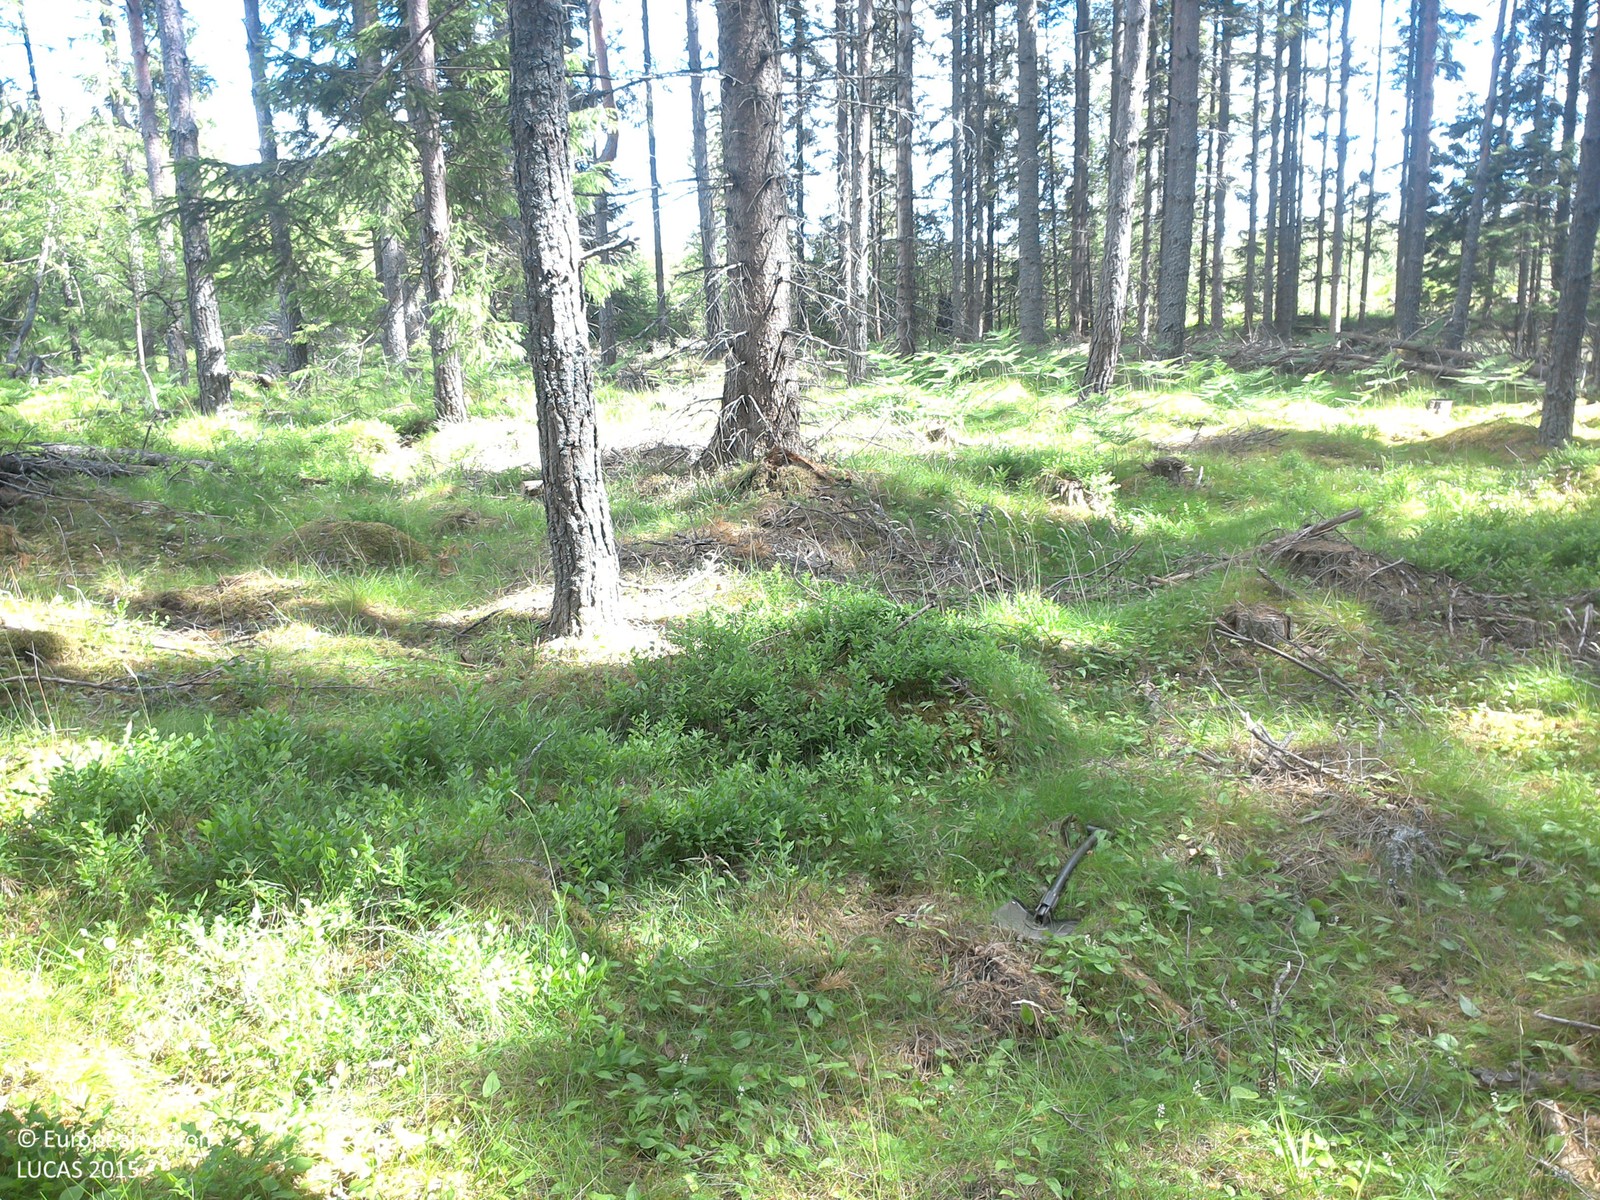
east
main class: Woodland
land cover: Pine dominated coniferous woodland
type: boreal forest
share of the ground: 50 - 75 %
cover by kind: coniferous forest trees 65 %, lichens and mosses 30 %, herbaceous plants 5 %
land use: Forestry
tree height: > 5 m
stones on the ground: < 10 %
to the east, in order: Pine dominated coniferous woodland; Spruce dominated coniferous woodland; Pine dominated coniferous woodland; Spruce dominated coniferous woodland
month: June
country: SE
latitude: 58.0528
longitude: 15.5023
